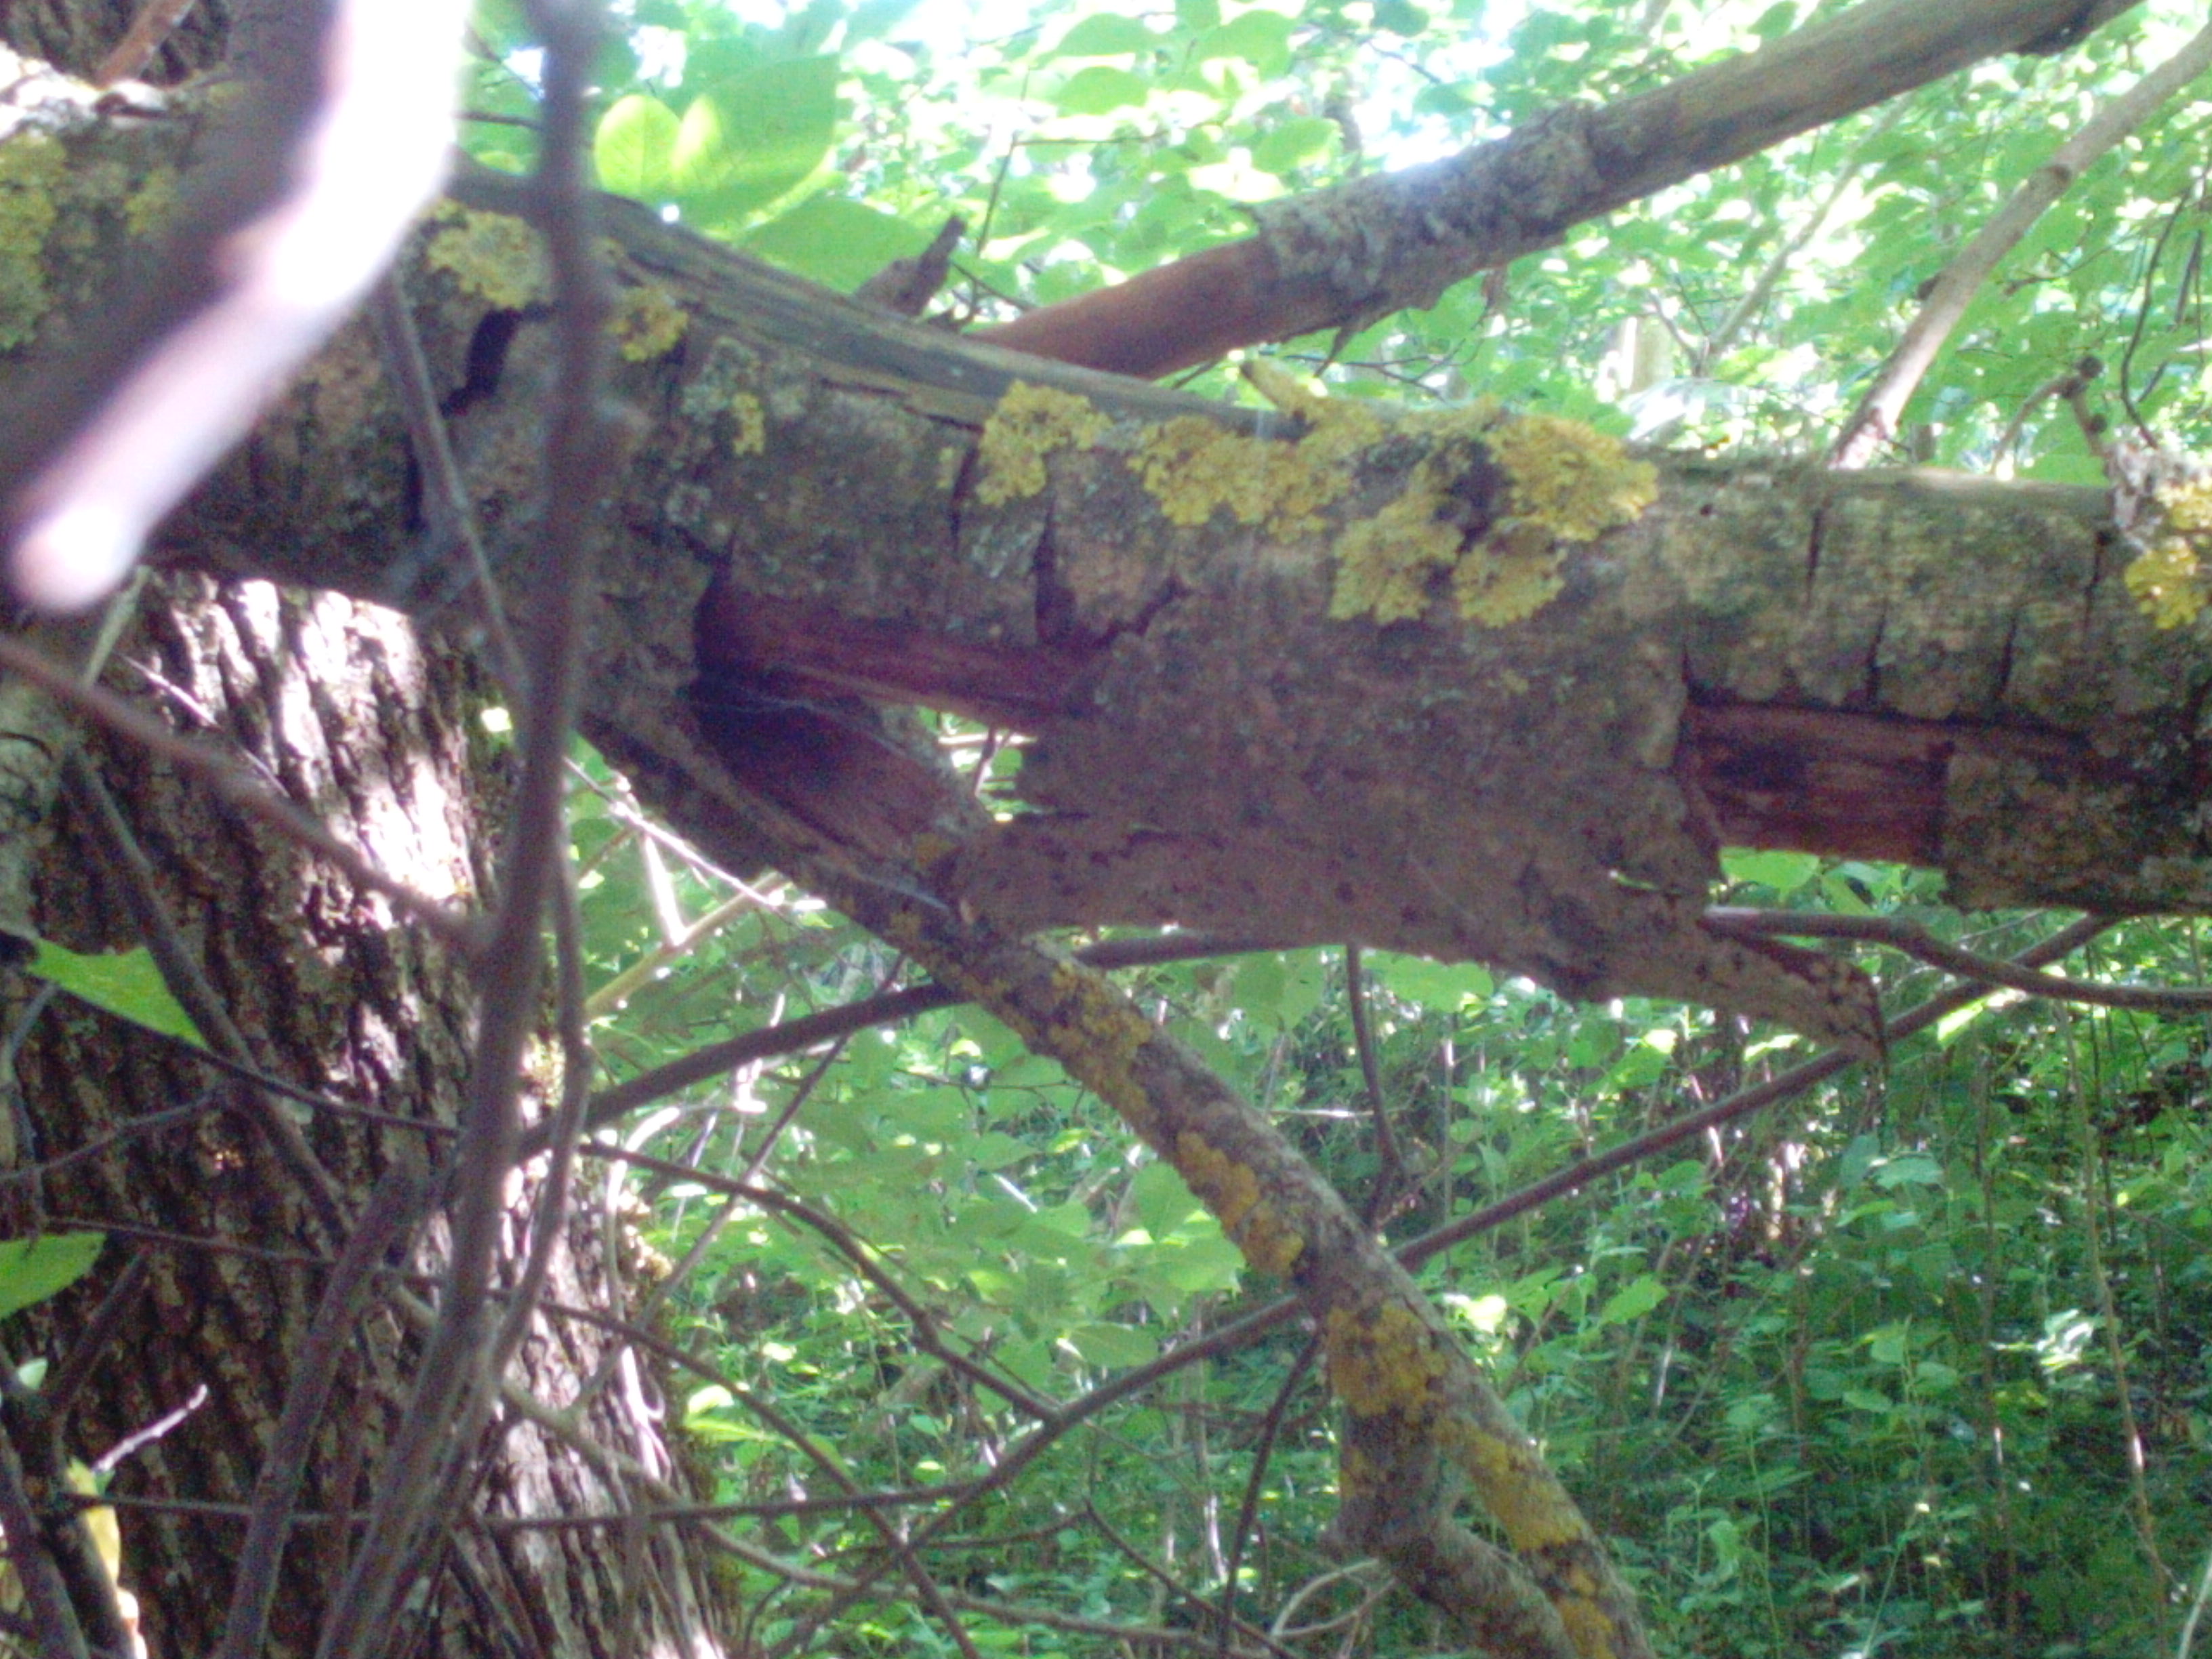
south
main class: Woodland
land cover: Broadleaved woodland
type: non-riverine alder, birch or aspen forest
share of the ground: > 75 %
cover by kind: broadleaved forest trees 80 %, herbaceous plants 20 %
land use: Forestry
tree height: > 5 m
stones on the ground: < 10 %
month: July
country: LV
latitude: 56.5495
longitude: 22.2034
